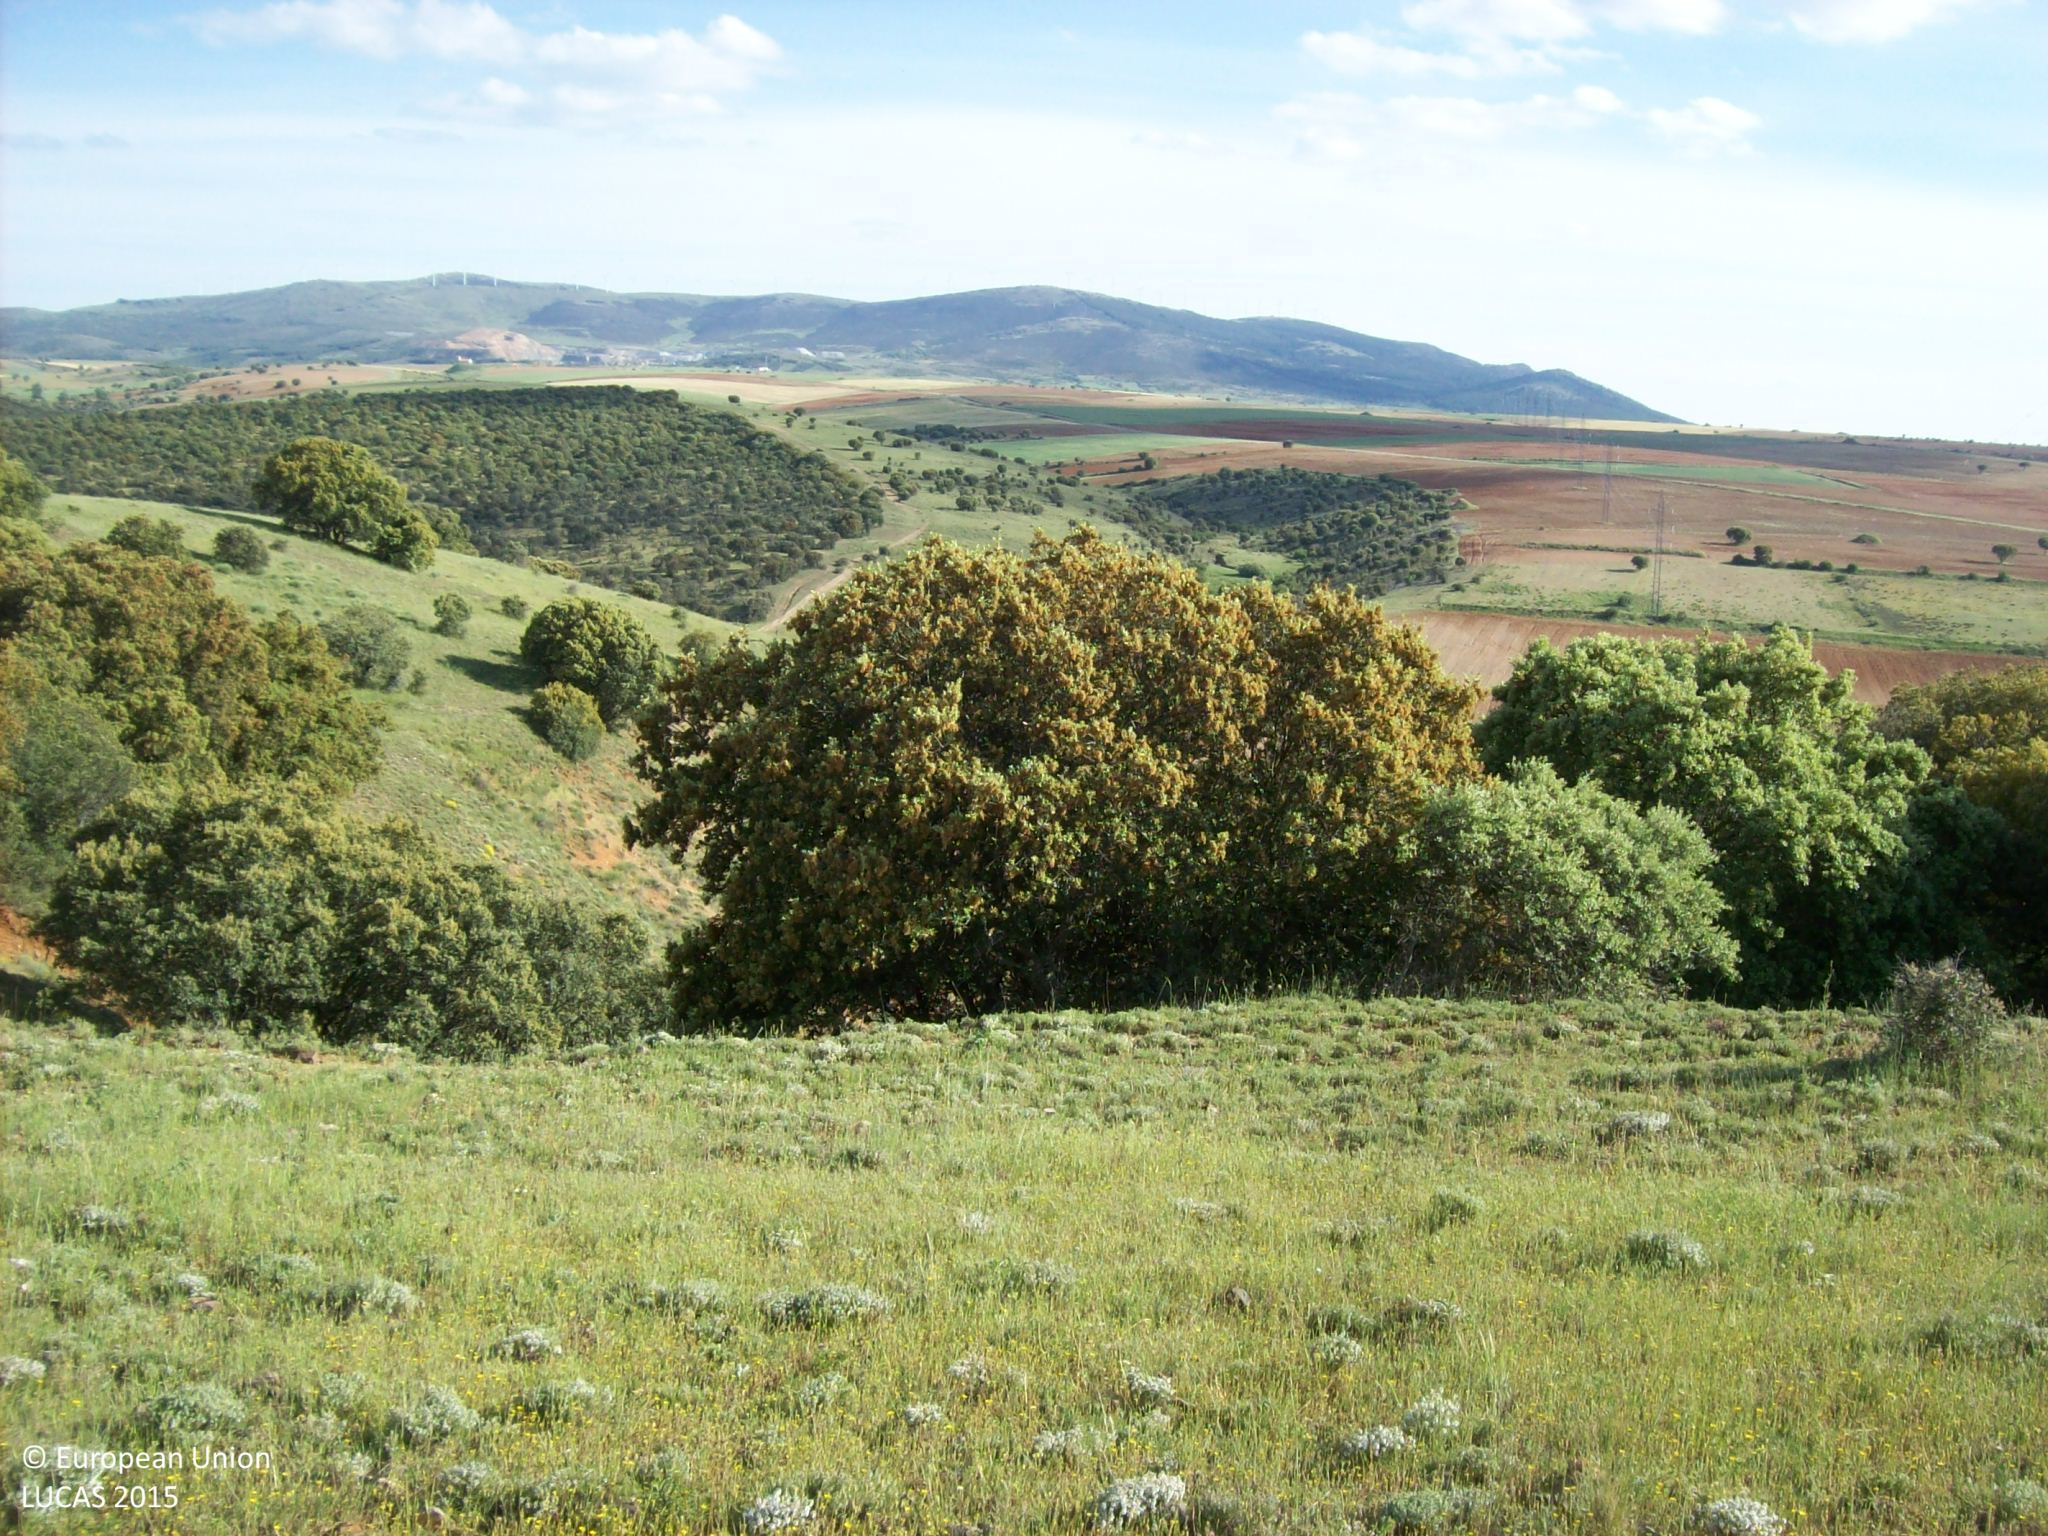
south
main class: Shrubland
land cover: Shrubland with sparse tree cover
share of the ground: 50 - 75 %
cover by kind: shrubs 60 %, lichens and mosses 20 %, herbaceous plants 15 %, broadleaved forest trees 5 %
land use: Semi-natural and natural areas not in use
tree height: < 5 m
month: May
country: ES
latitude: 40.7833
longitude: -4.4748
